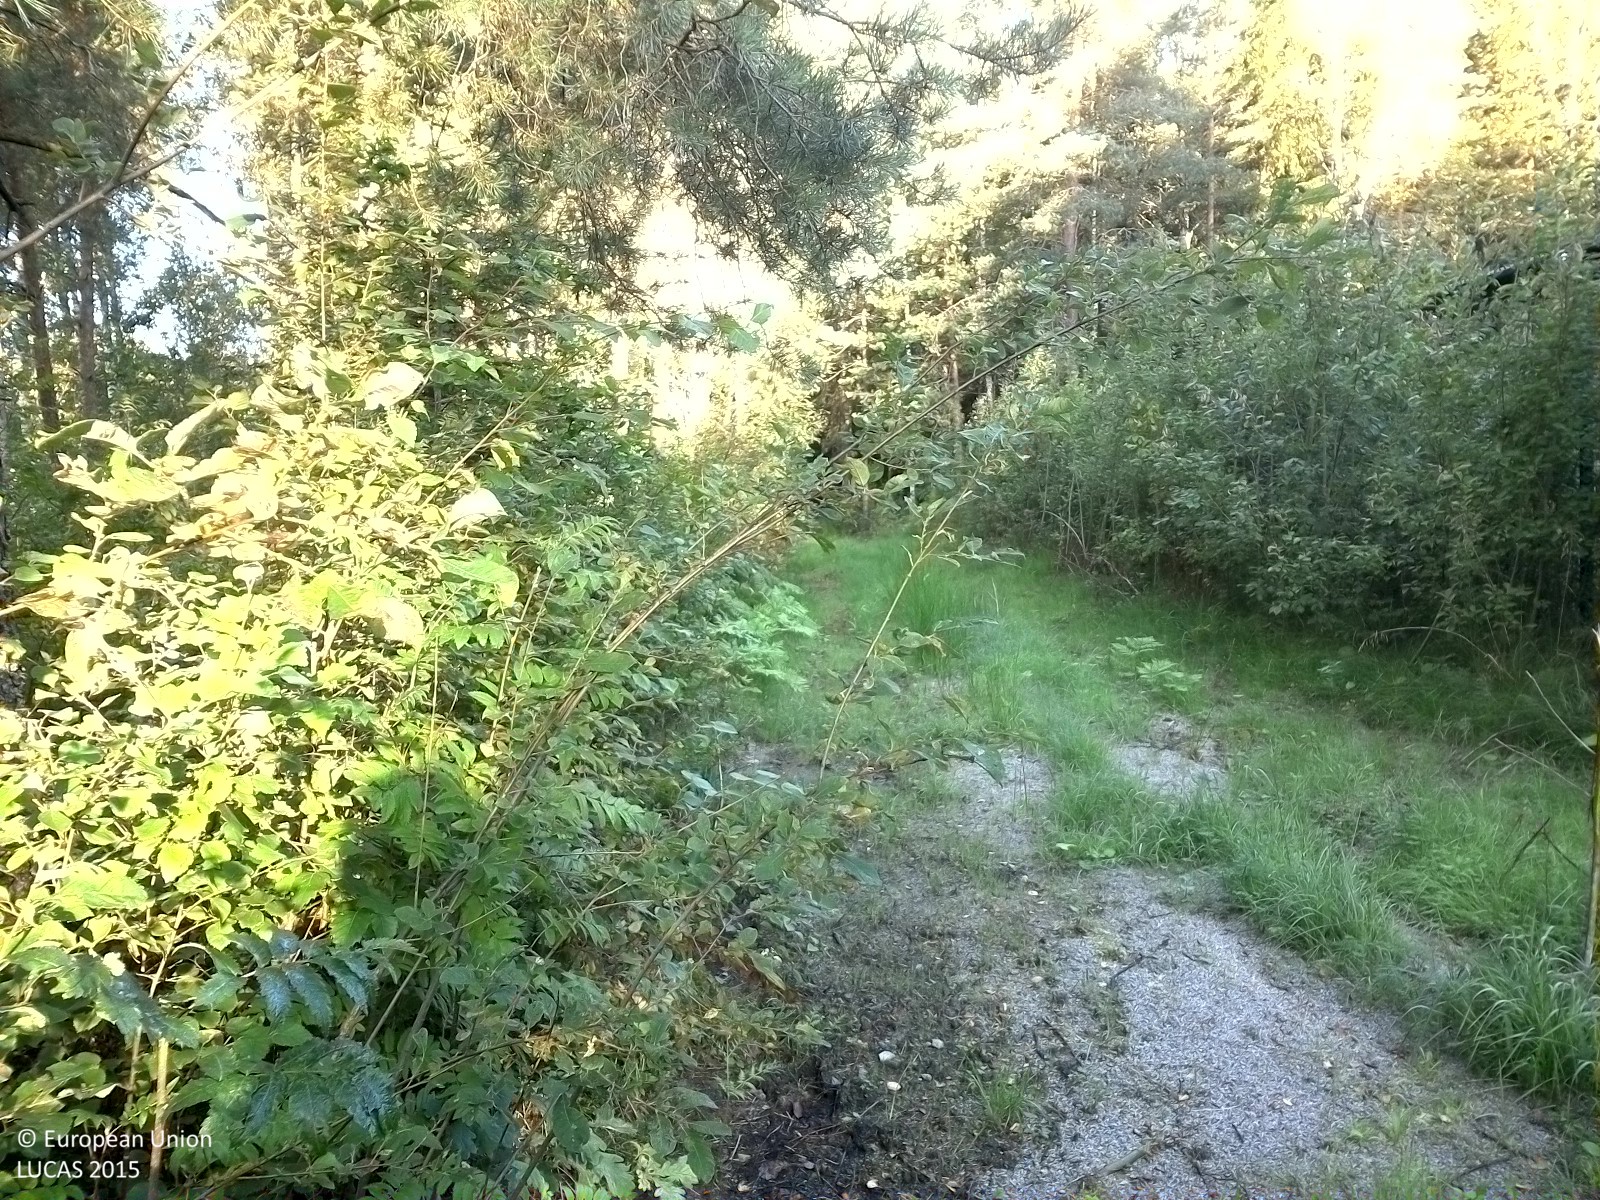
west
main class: Woodland
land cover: Other mixed woodland
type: hemiboreal forest and nemoral coniferous forest and mixed broadleaved-coniferous forest
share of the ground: 25 - 50 %
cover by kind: herbaceous plants 45 %, broadleaved forest trees 25 %, coniferous forest trees 20 %, lichens and mosses 10 %
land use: Forestry
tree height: > 5 m
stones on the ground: < 10 %
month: August
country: SE
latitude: 59.2755
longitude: 15.1331
